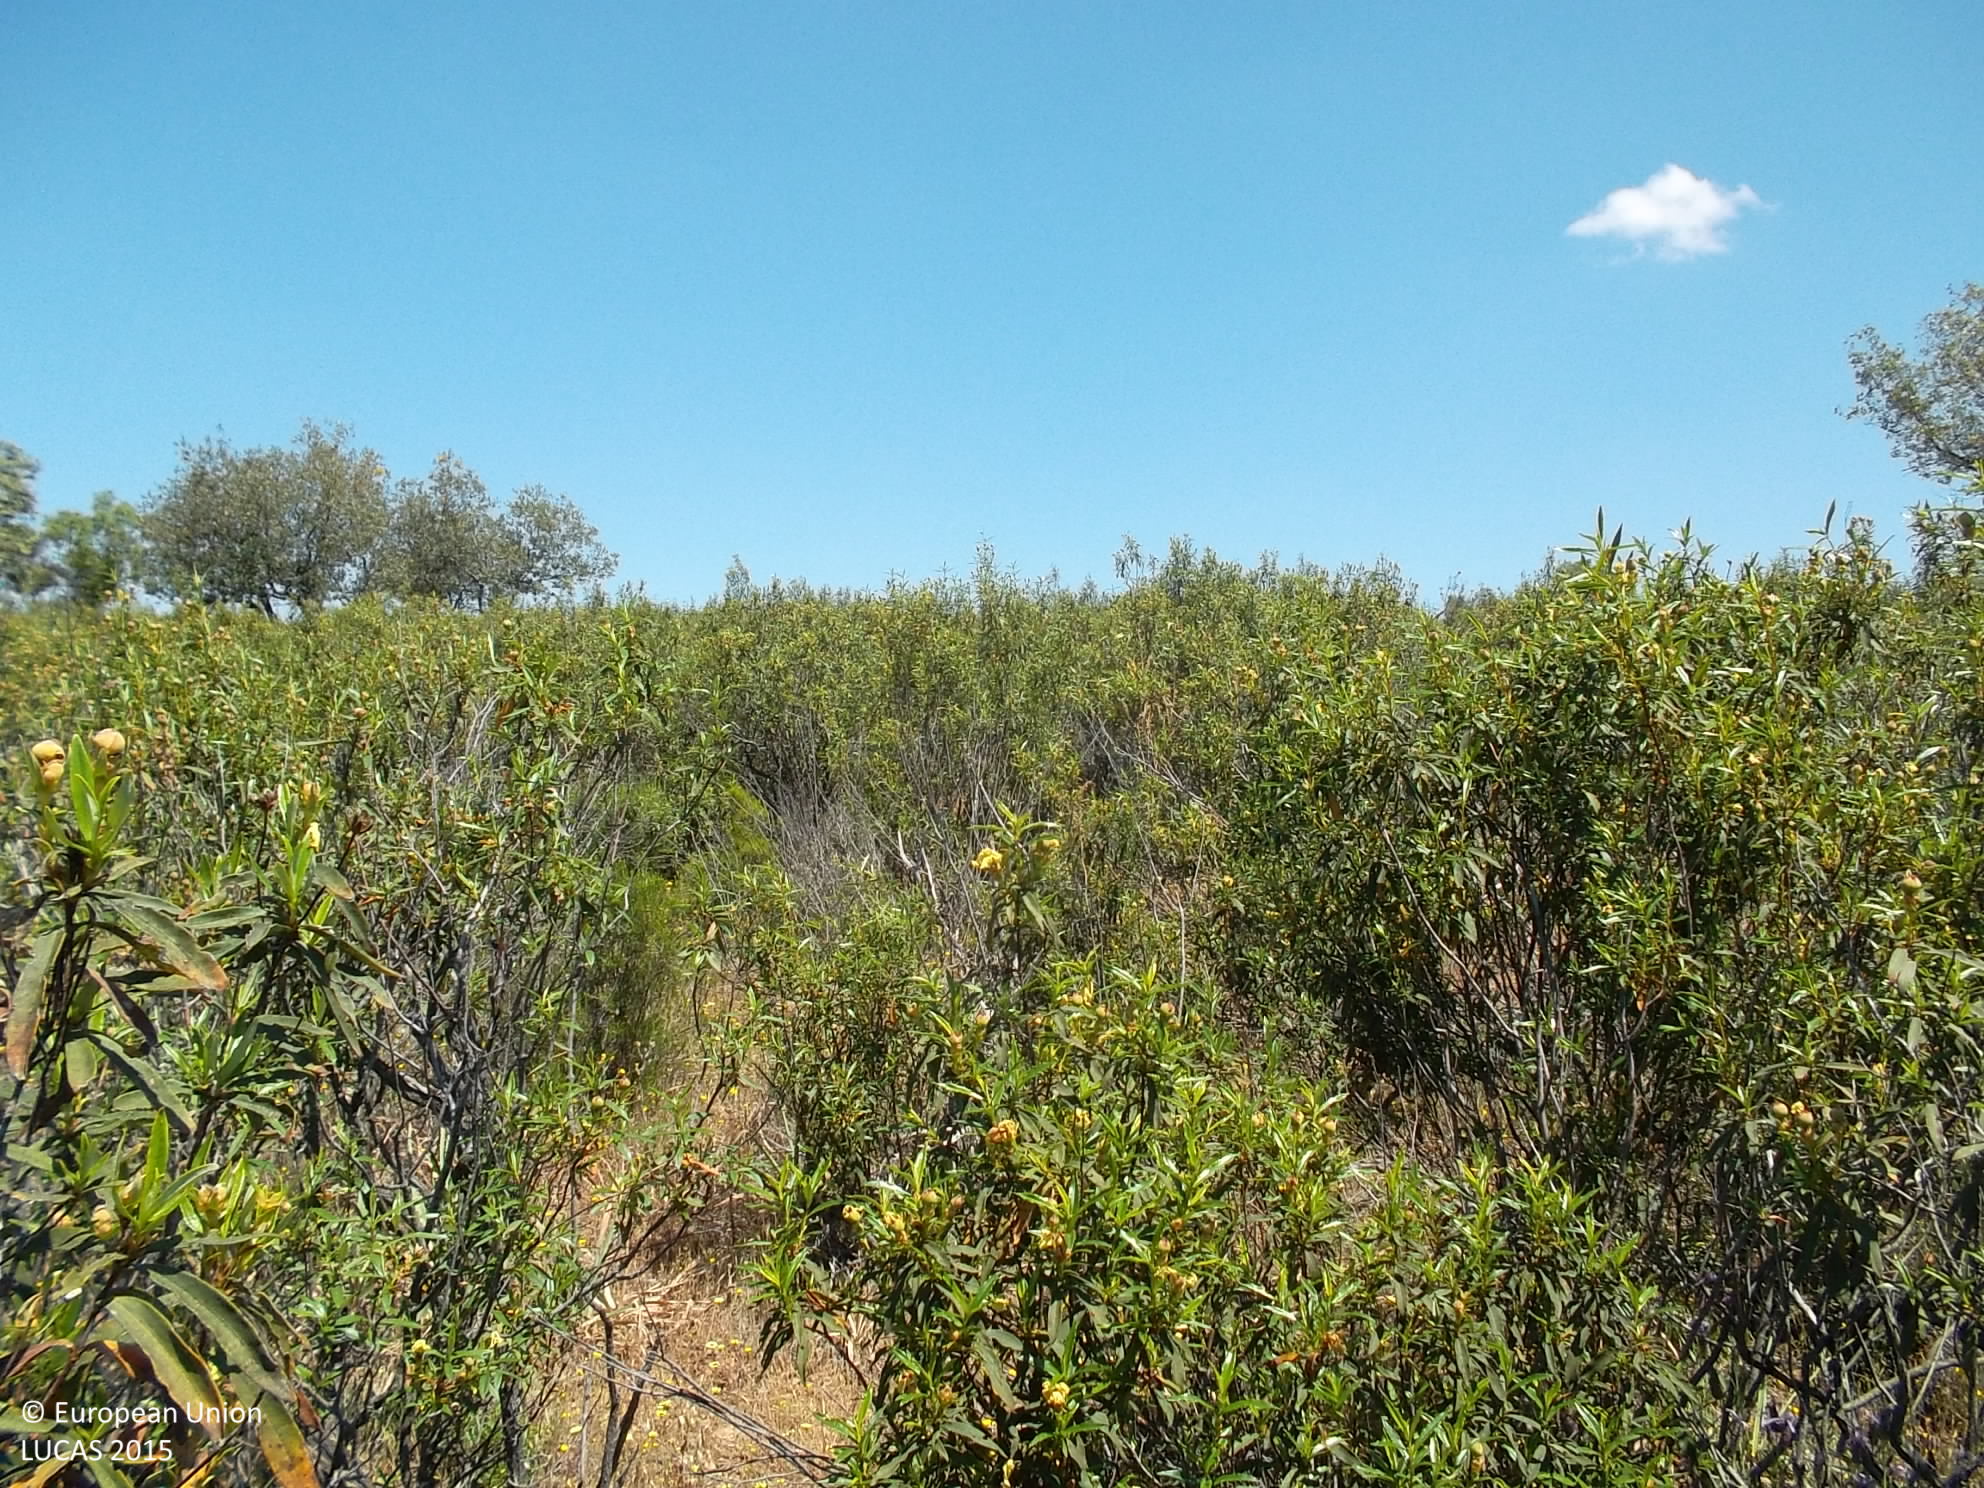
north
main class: Shrubland
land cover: Shrubland with sparse tree cover
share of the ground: > 75 %
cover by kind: shrubs 95 %, broadleaved forest trees 5 %
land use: Forestry
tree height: < 5 m
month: May
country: ES
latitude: 38.5211
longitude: -4.3910
